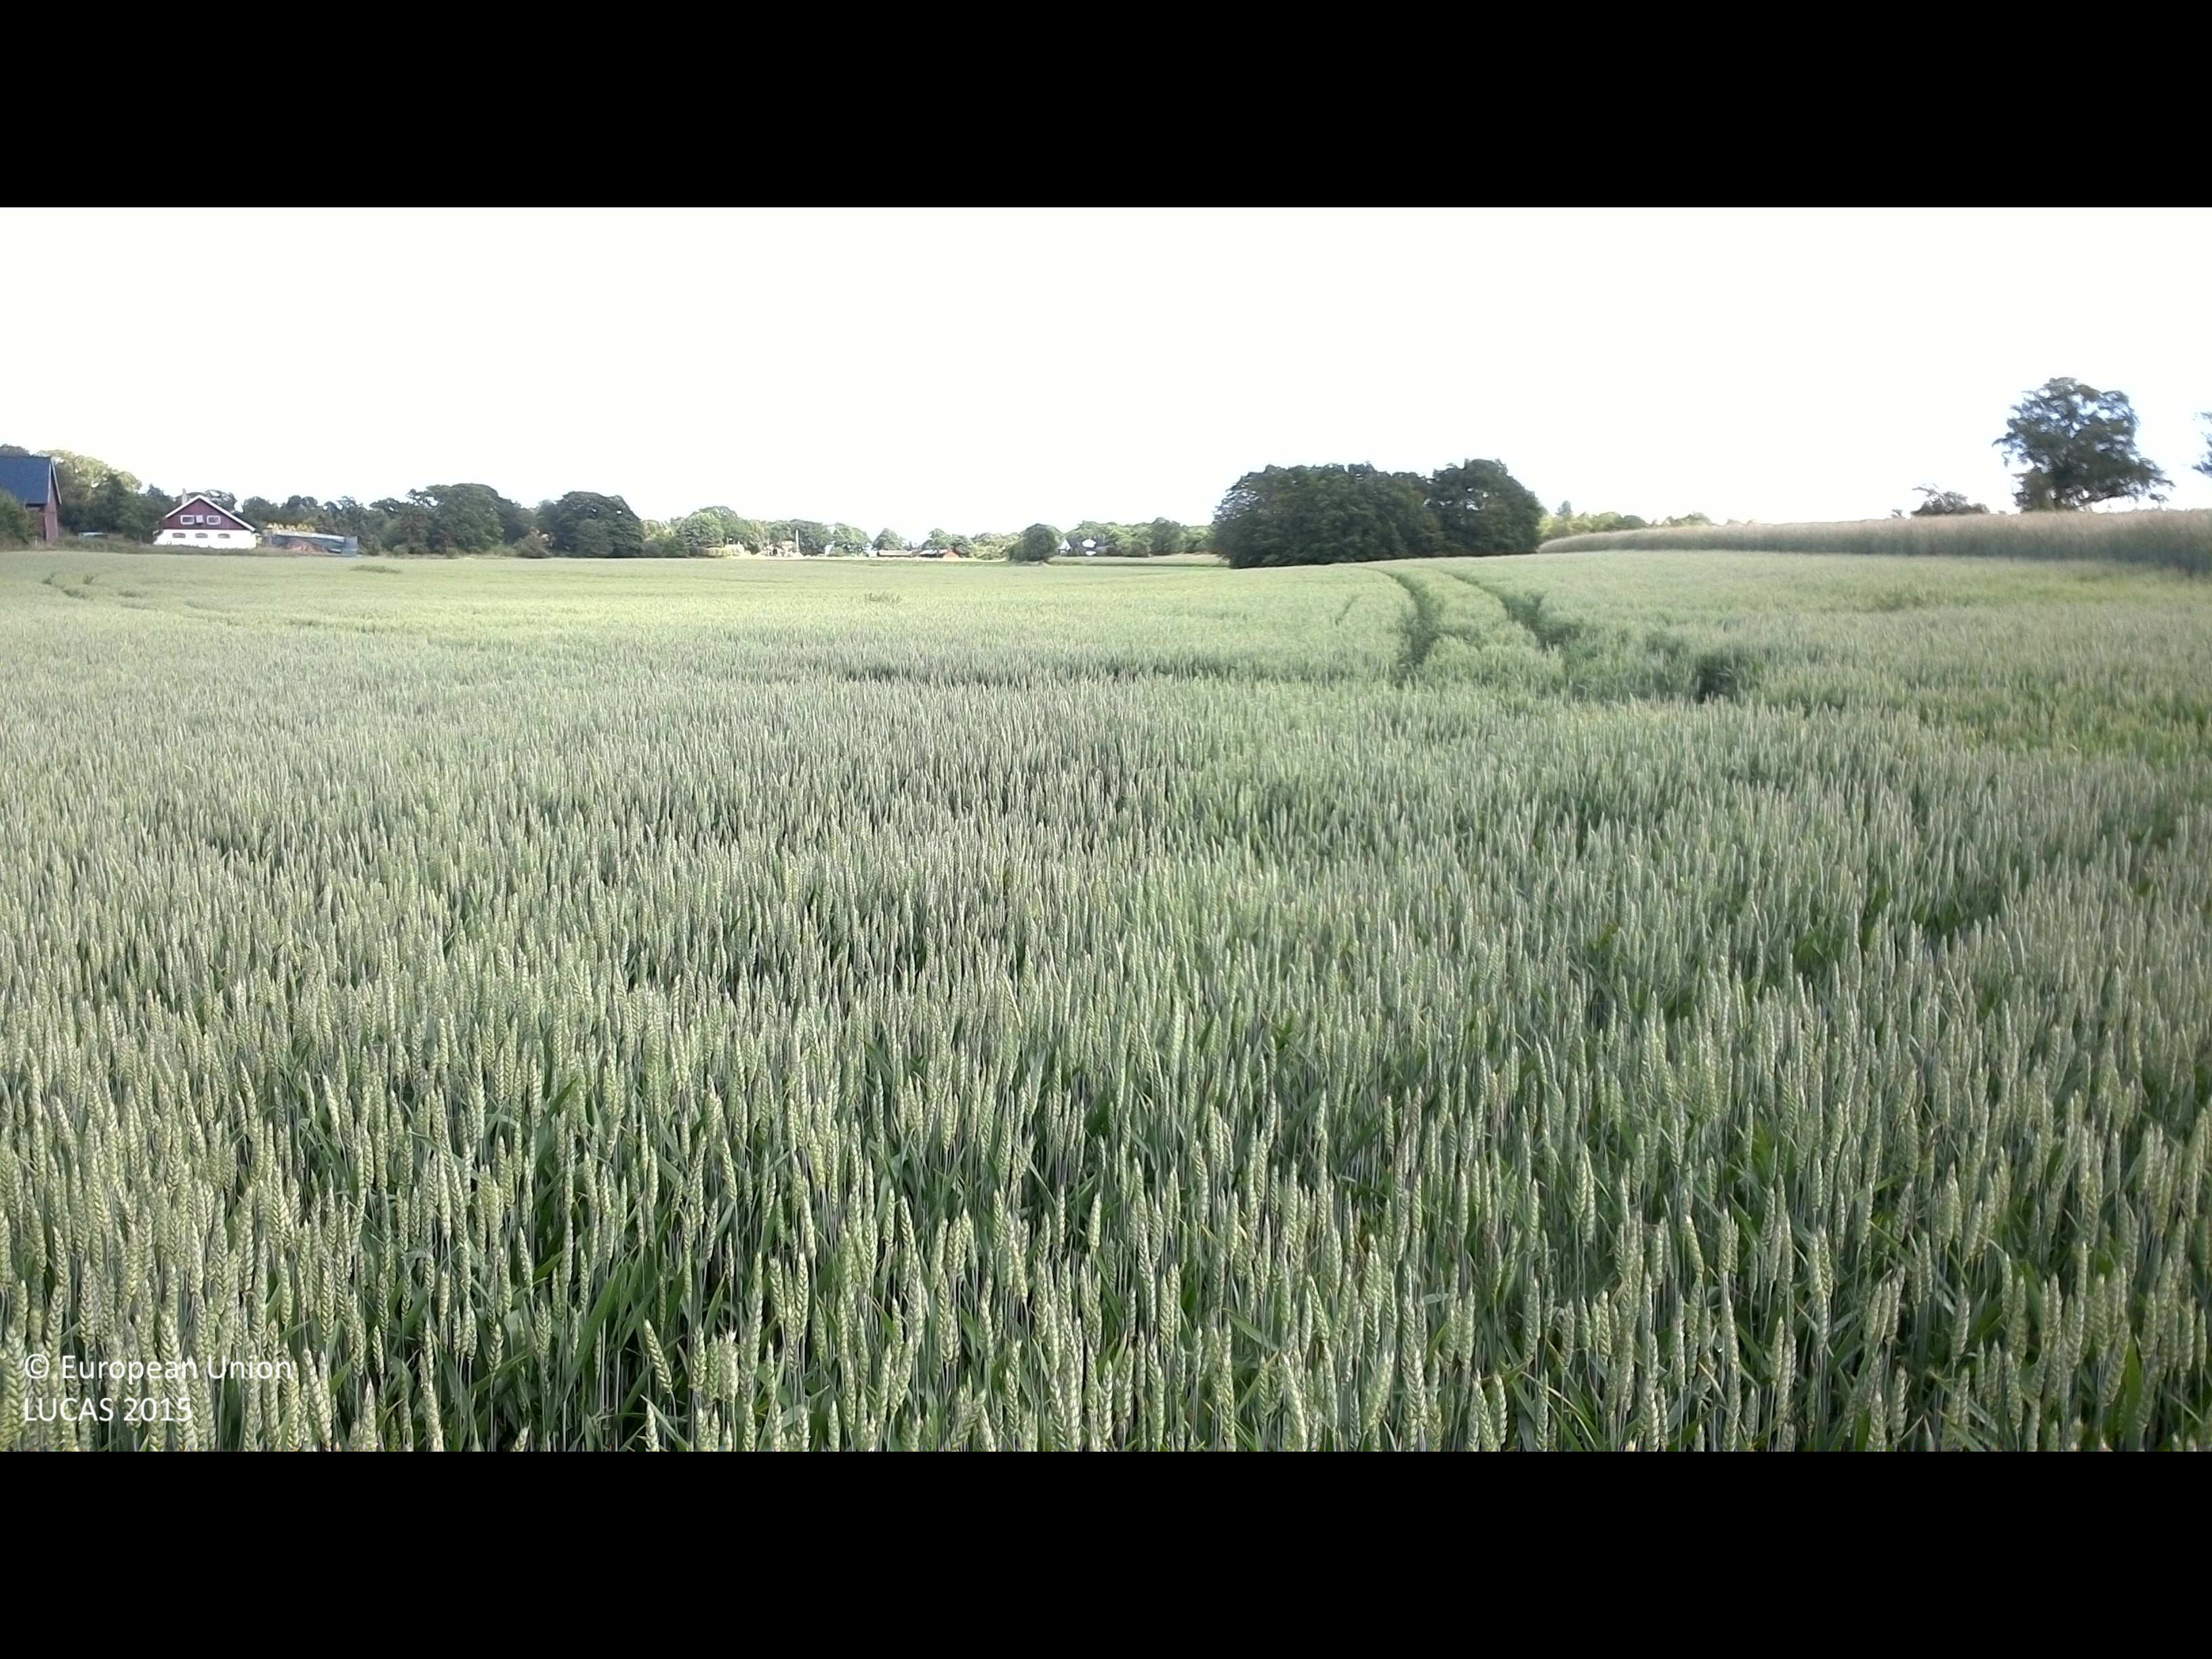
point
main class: Cropland
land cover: Common wheat
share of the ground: > 75 %
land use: Agriculture (excluding fallow land and kitchen gardens)
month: June
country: SE
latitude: 56.4045
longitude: 16.0774
